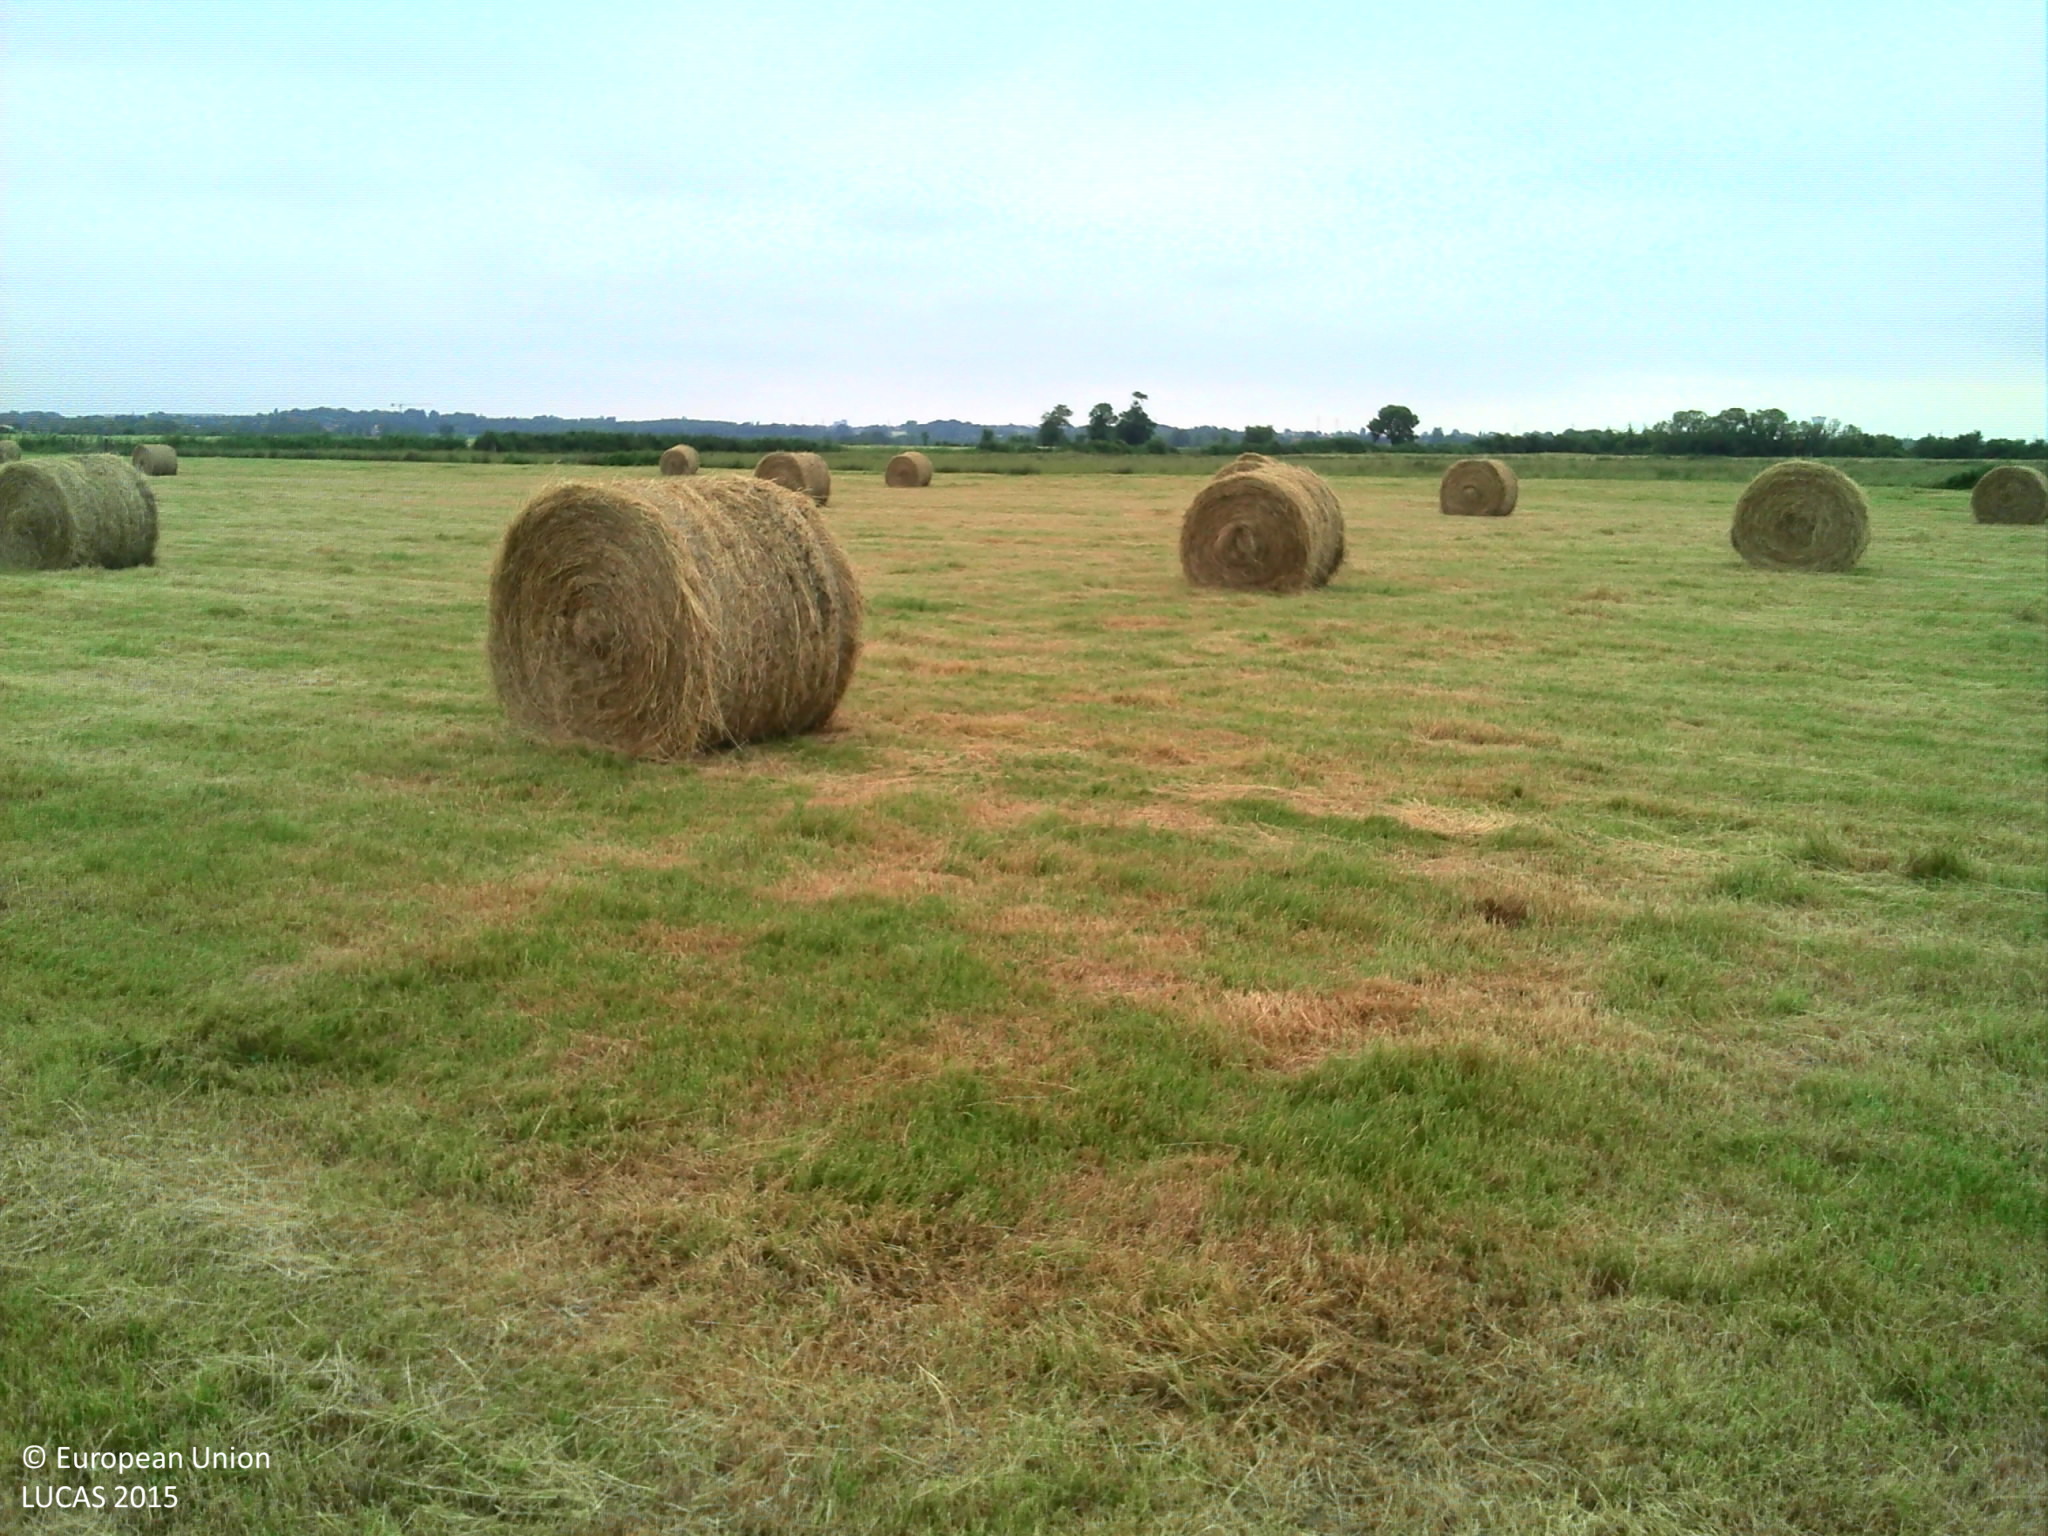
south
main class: Grassland
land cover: Grassland without tree/shrub cover
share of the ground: > 75 %
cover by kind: herbaceous plants 100 %
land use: Agriculture (excluding fallow land and kitchen gardens)
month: June
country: FR
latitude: 45.9733
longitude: -0.9081
